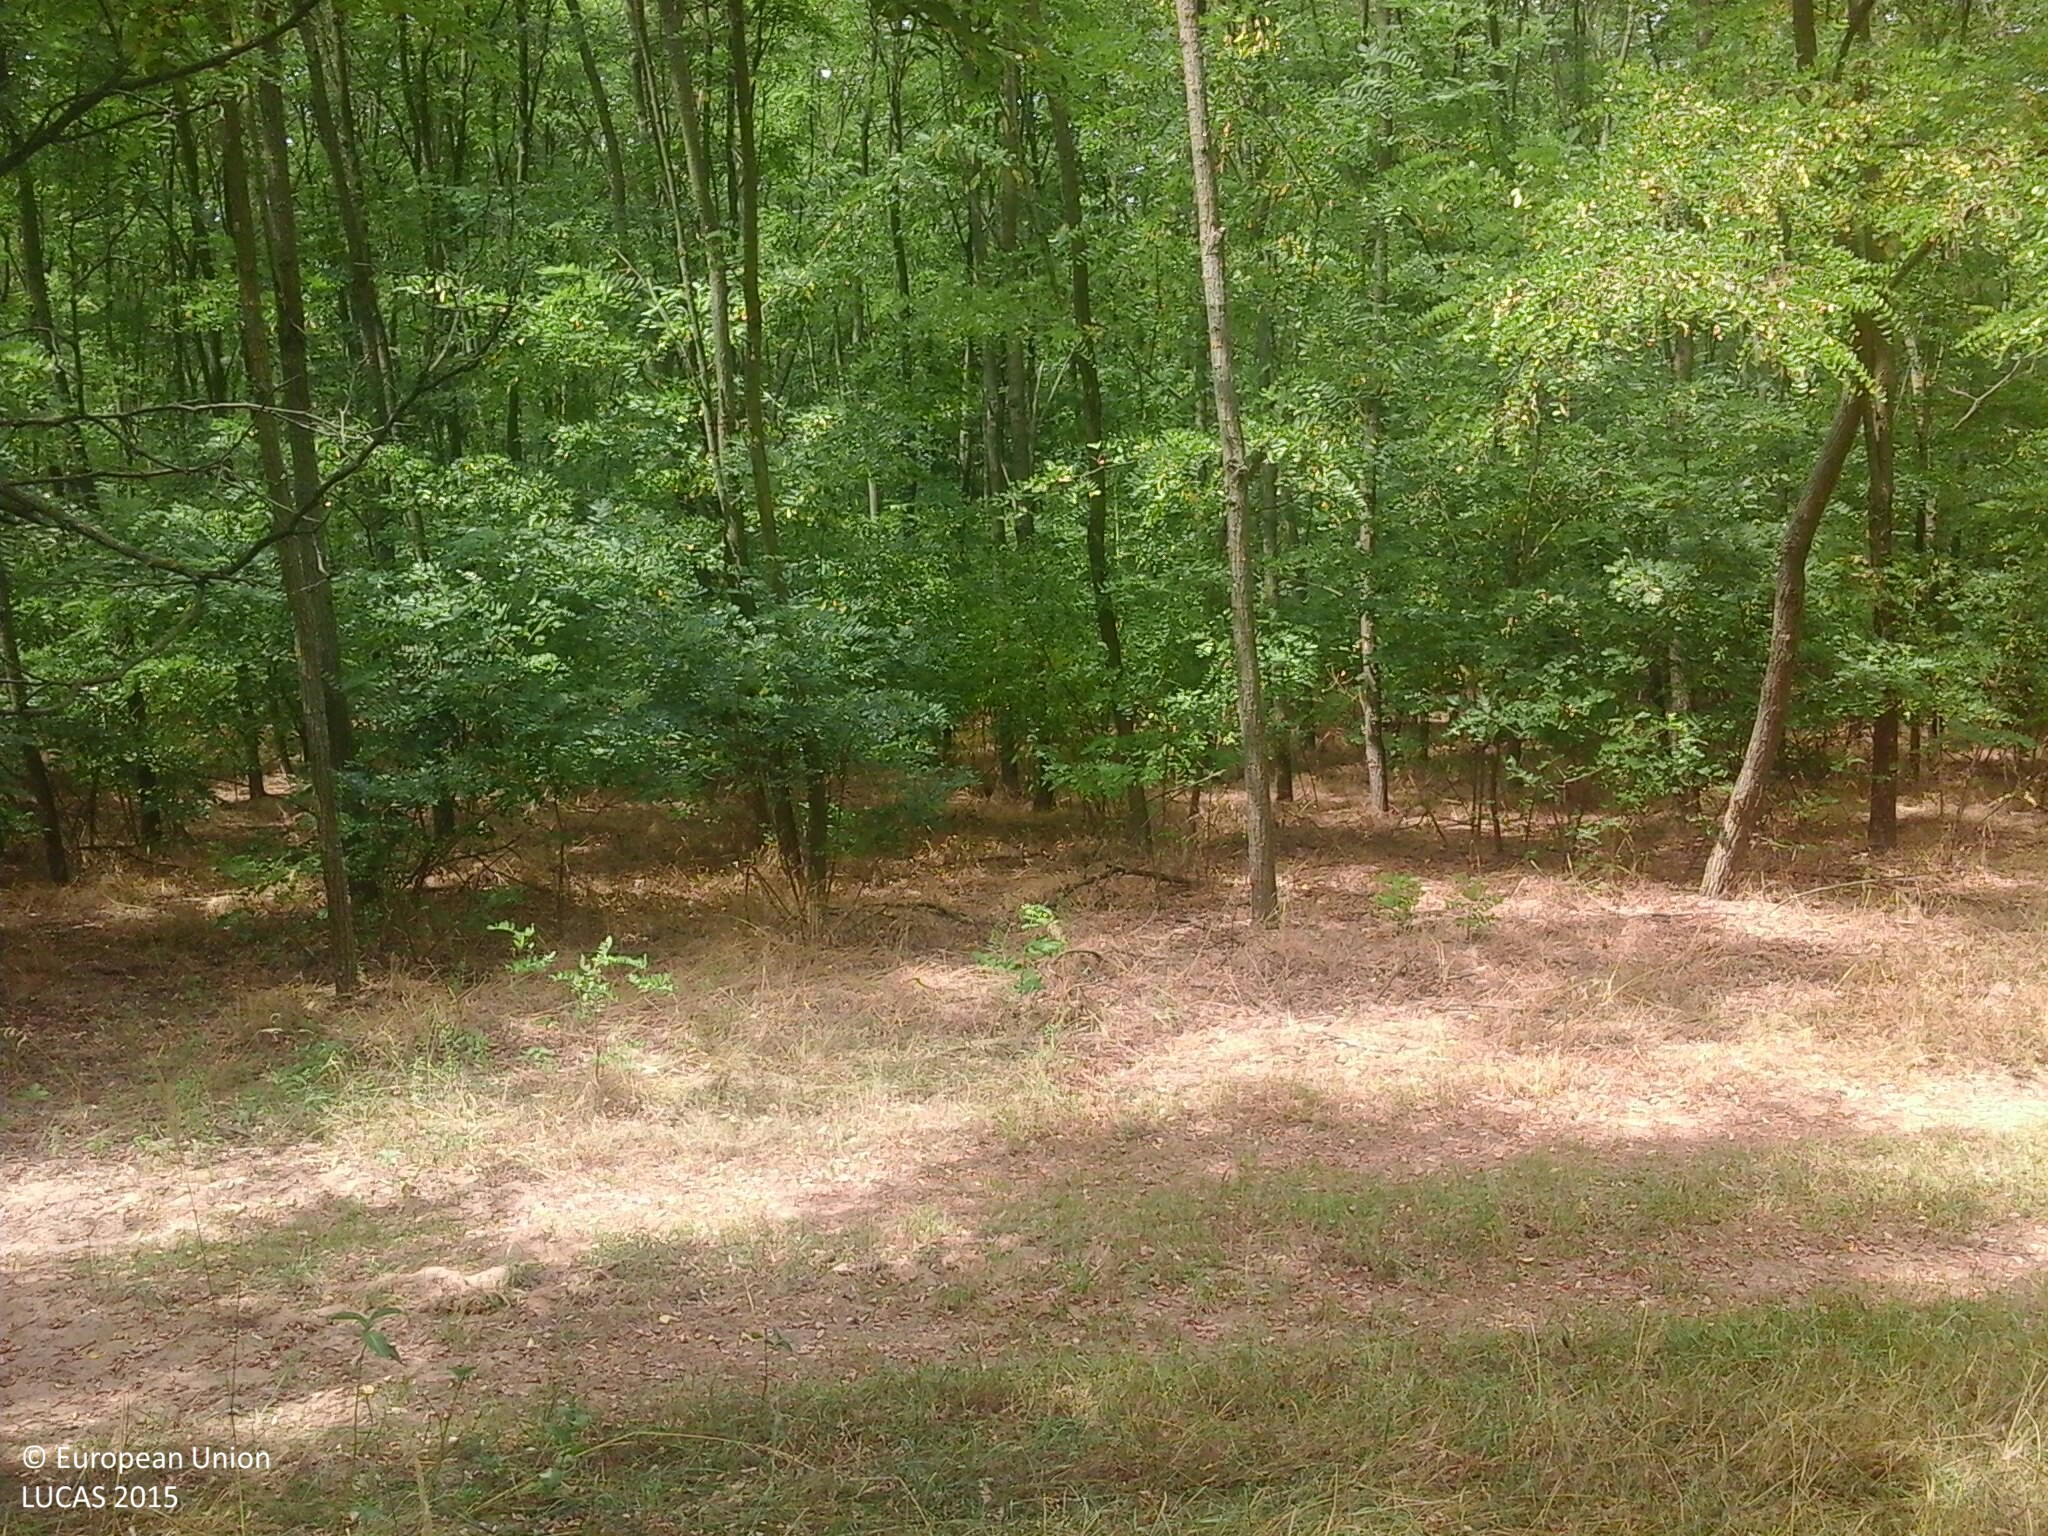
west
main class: Woodland
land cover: Broadleaved woodland
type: exotic forest
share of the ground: > 75 %
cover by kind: broadleaved forest trees 95 %, herbaceous plants 5 %
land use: Forestry
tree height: > 5 m
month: July
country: HU
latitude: 47.7546
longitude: 22.0980
